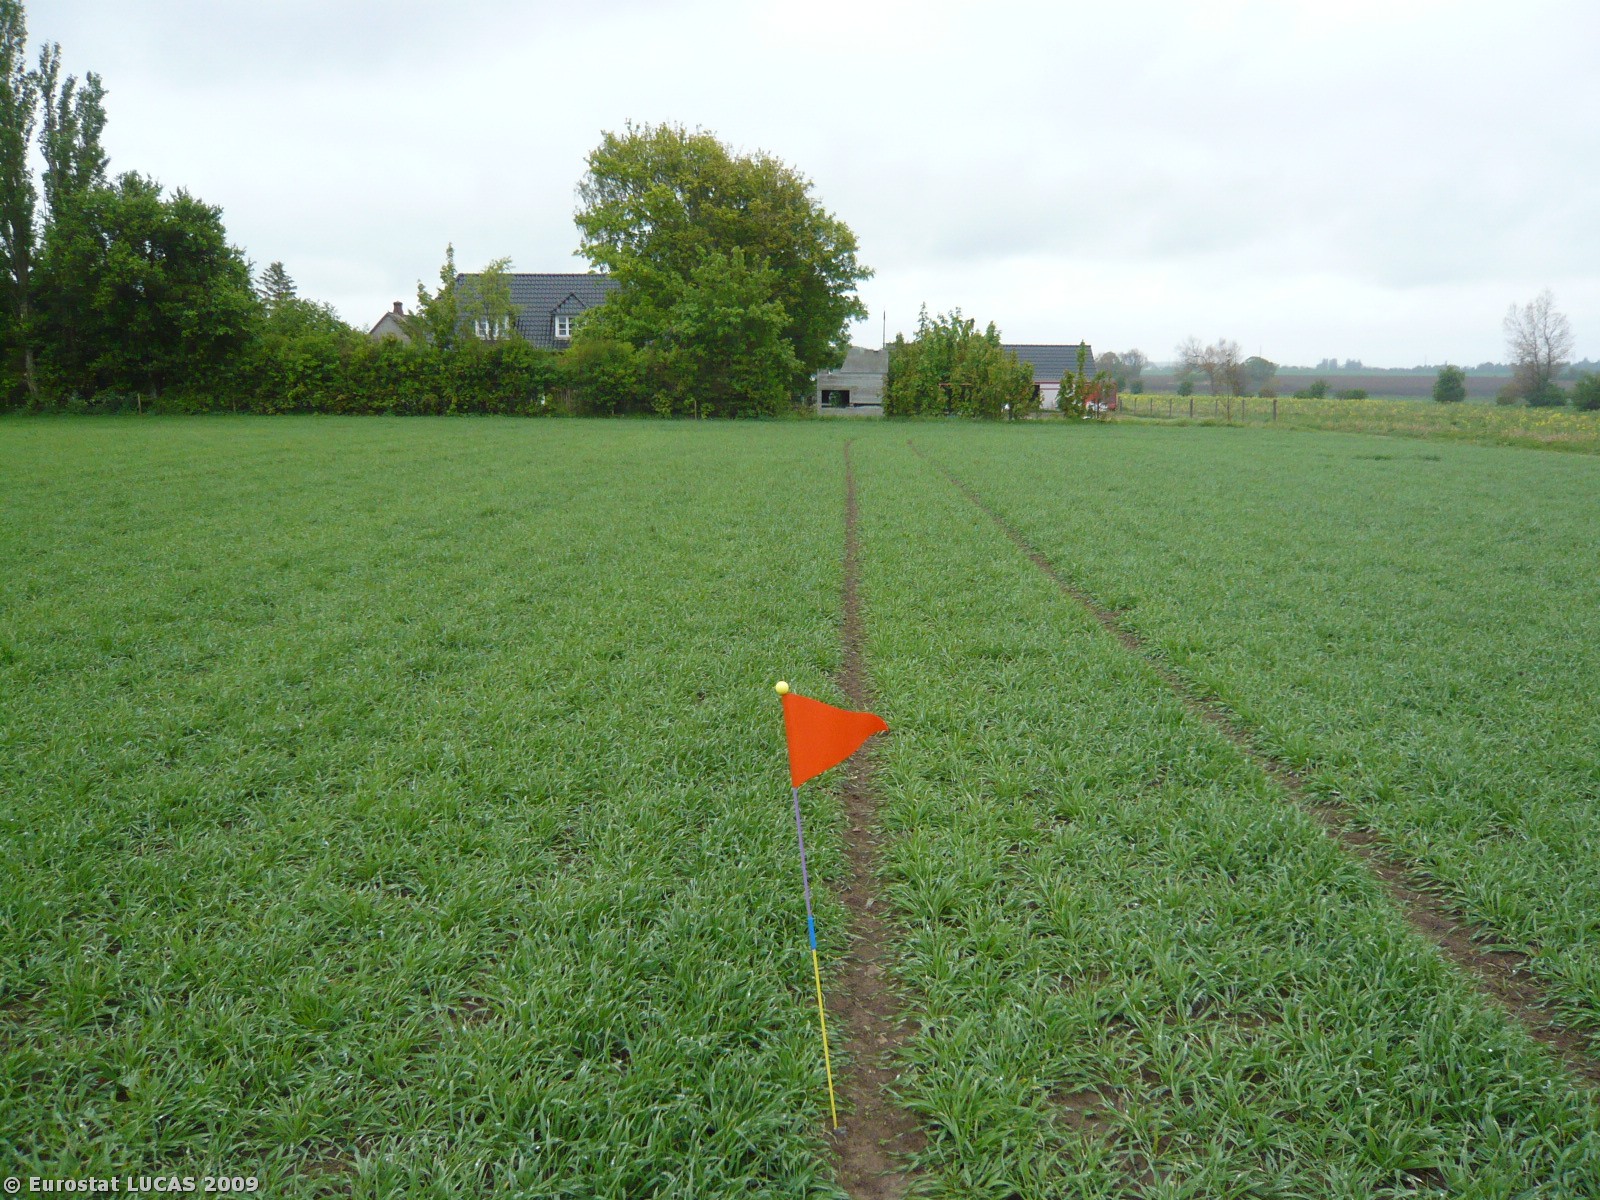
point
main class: Cropland
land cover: Barley
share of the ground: > 75 %
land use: Agriculture (excluding fallow land and kitchen gardens)
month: May
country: DK
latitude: 55.1319
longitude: 11.8338
